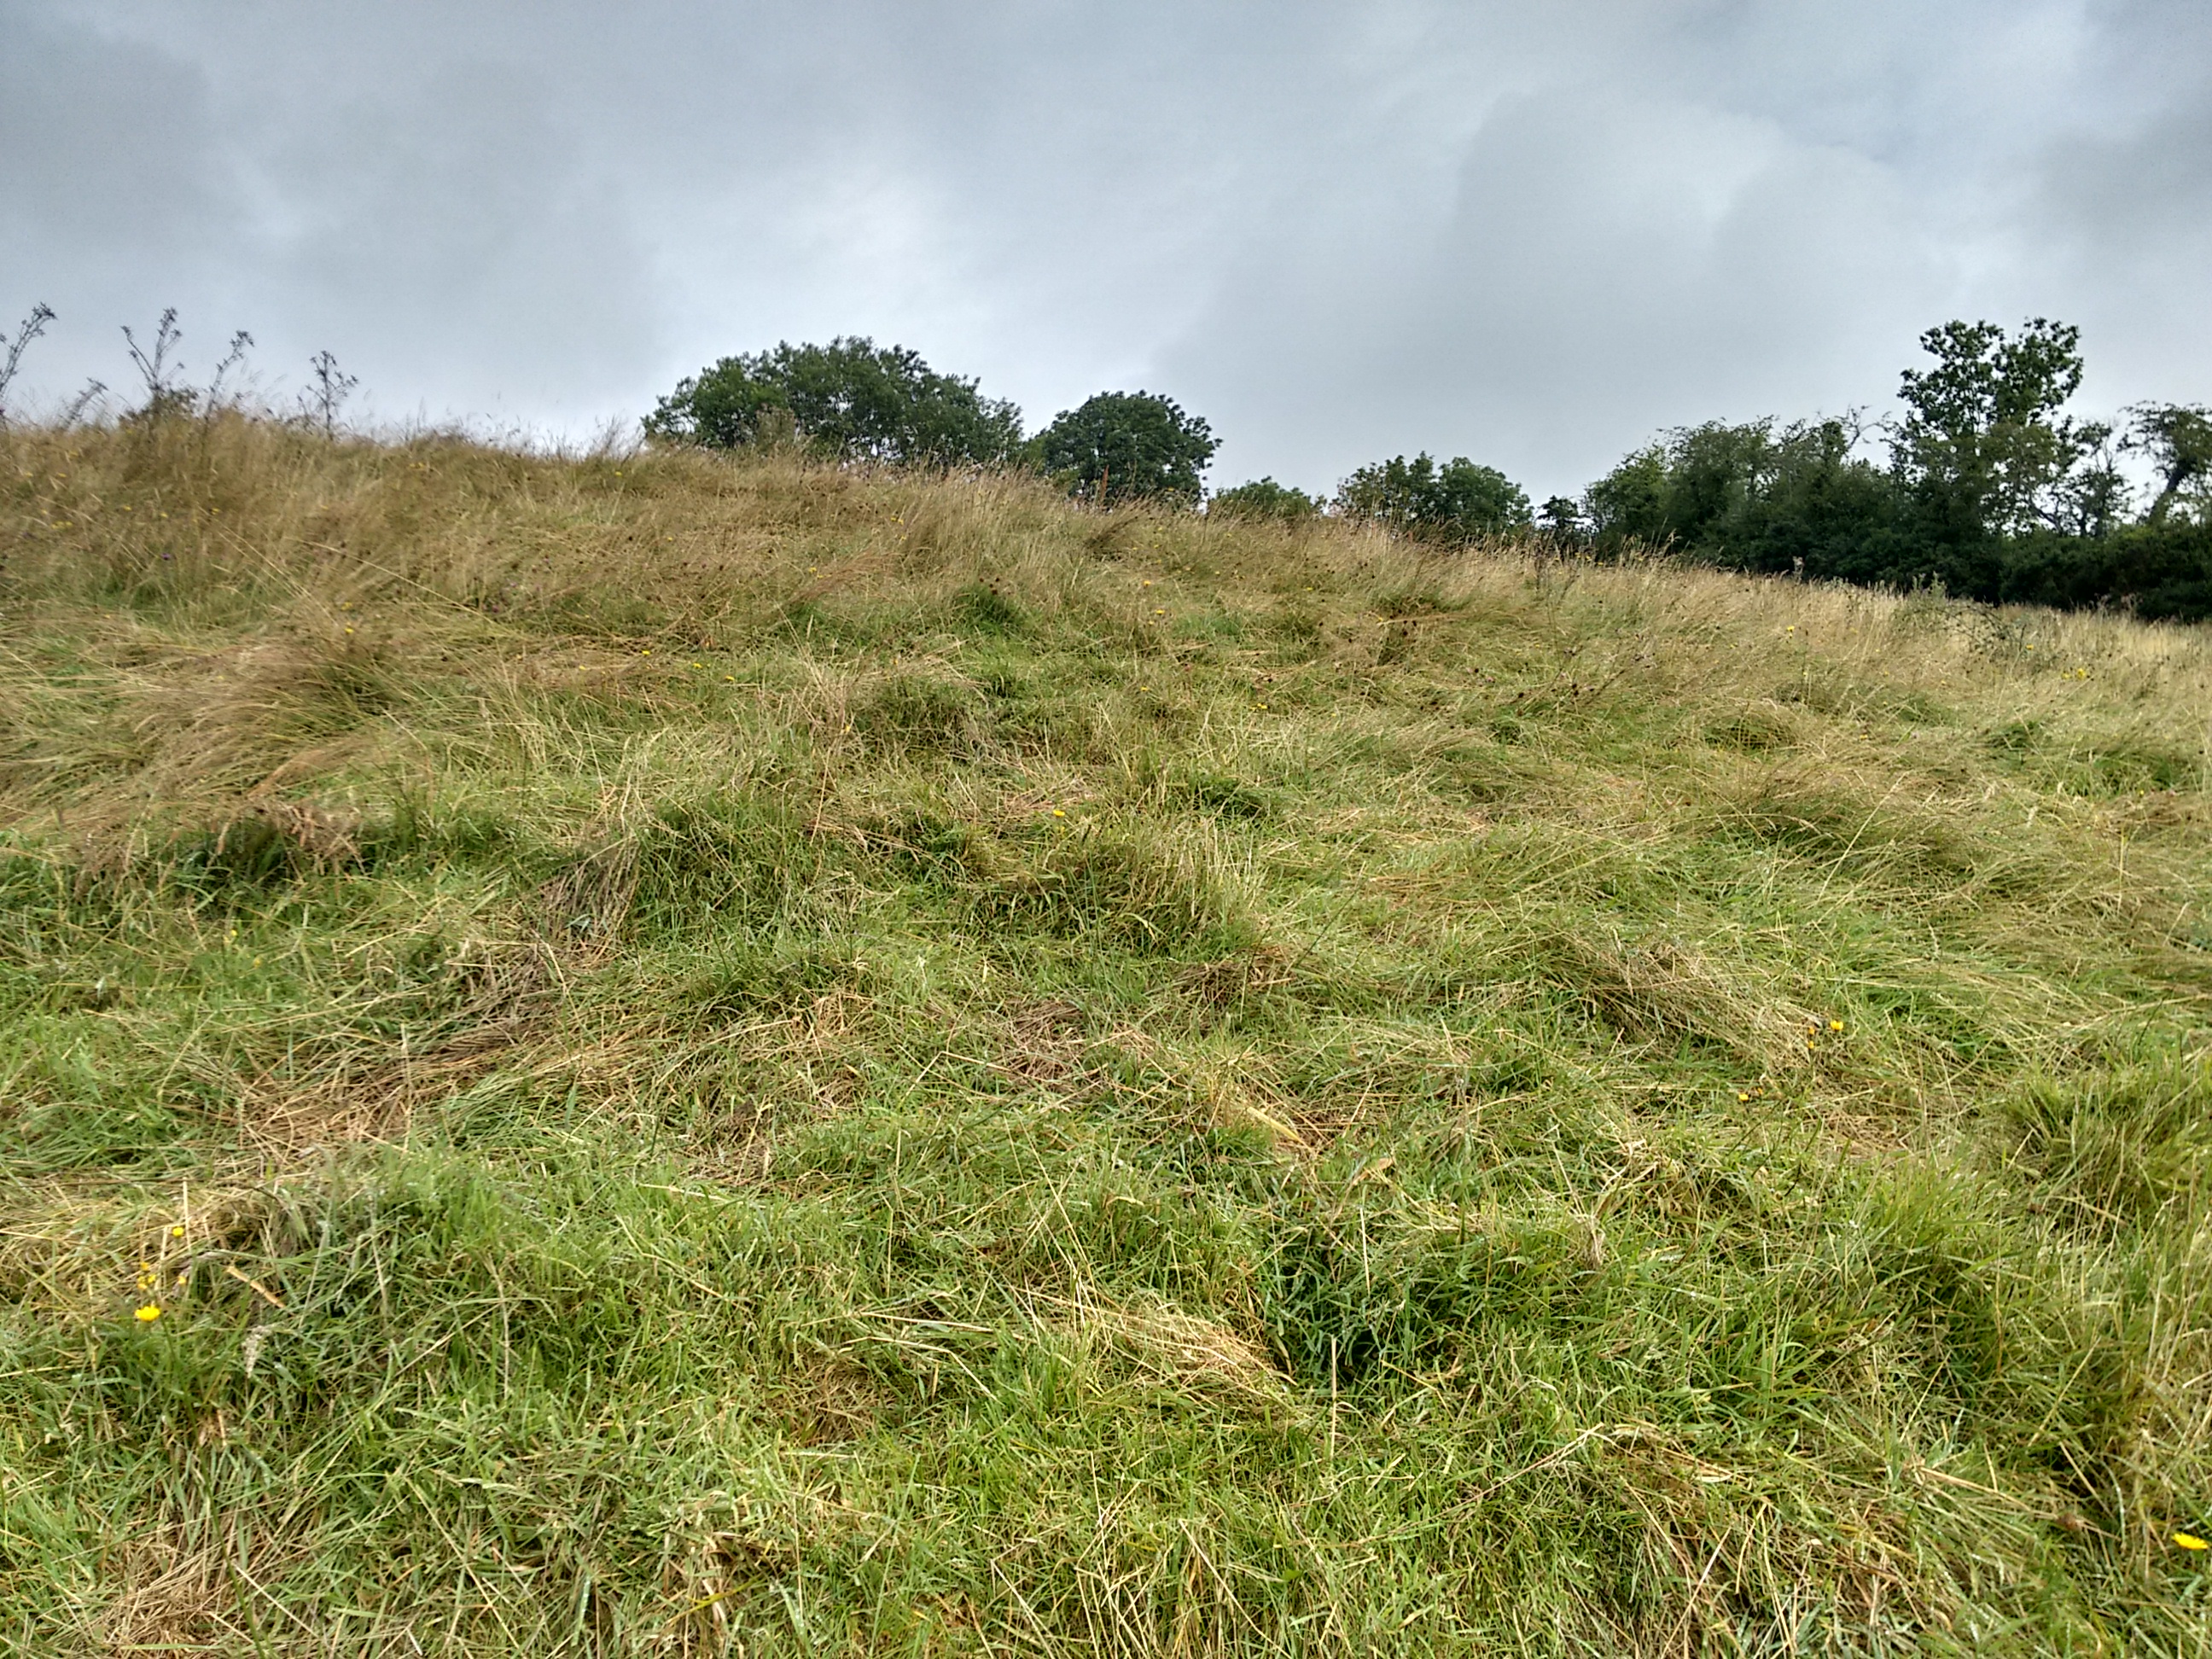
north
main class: Grassland
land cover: Grassland without tree/shrub cover
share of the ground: > 75 %
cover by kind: herbaceous plants 100 %
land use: Agriculture (excluding fallow land and kitchen gardens)
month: August
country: GB
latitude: 54.3719
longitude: -6.7730
